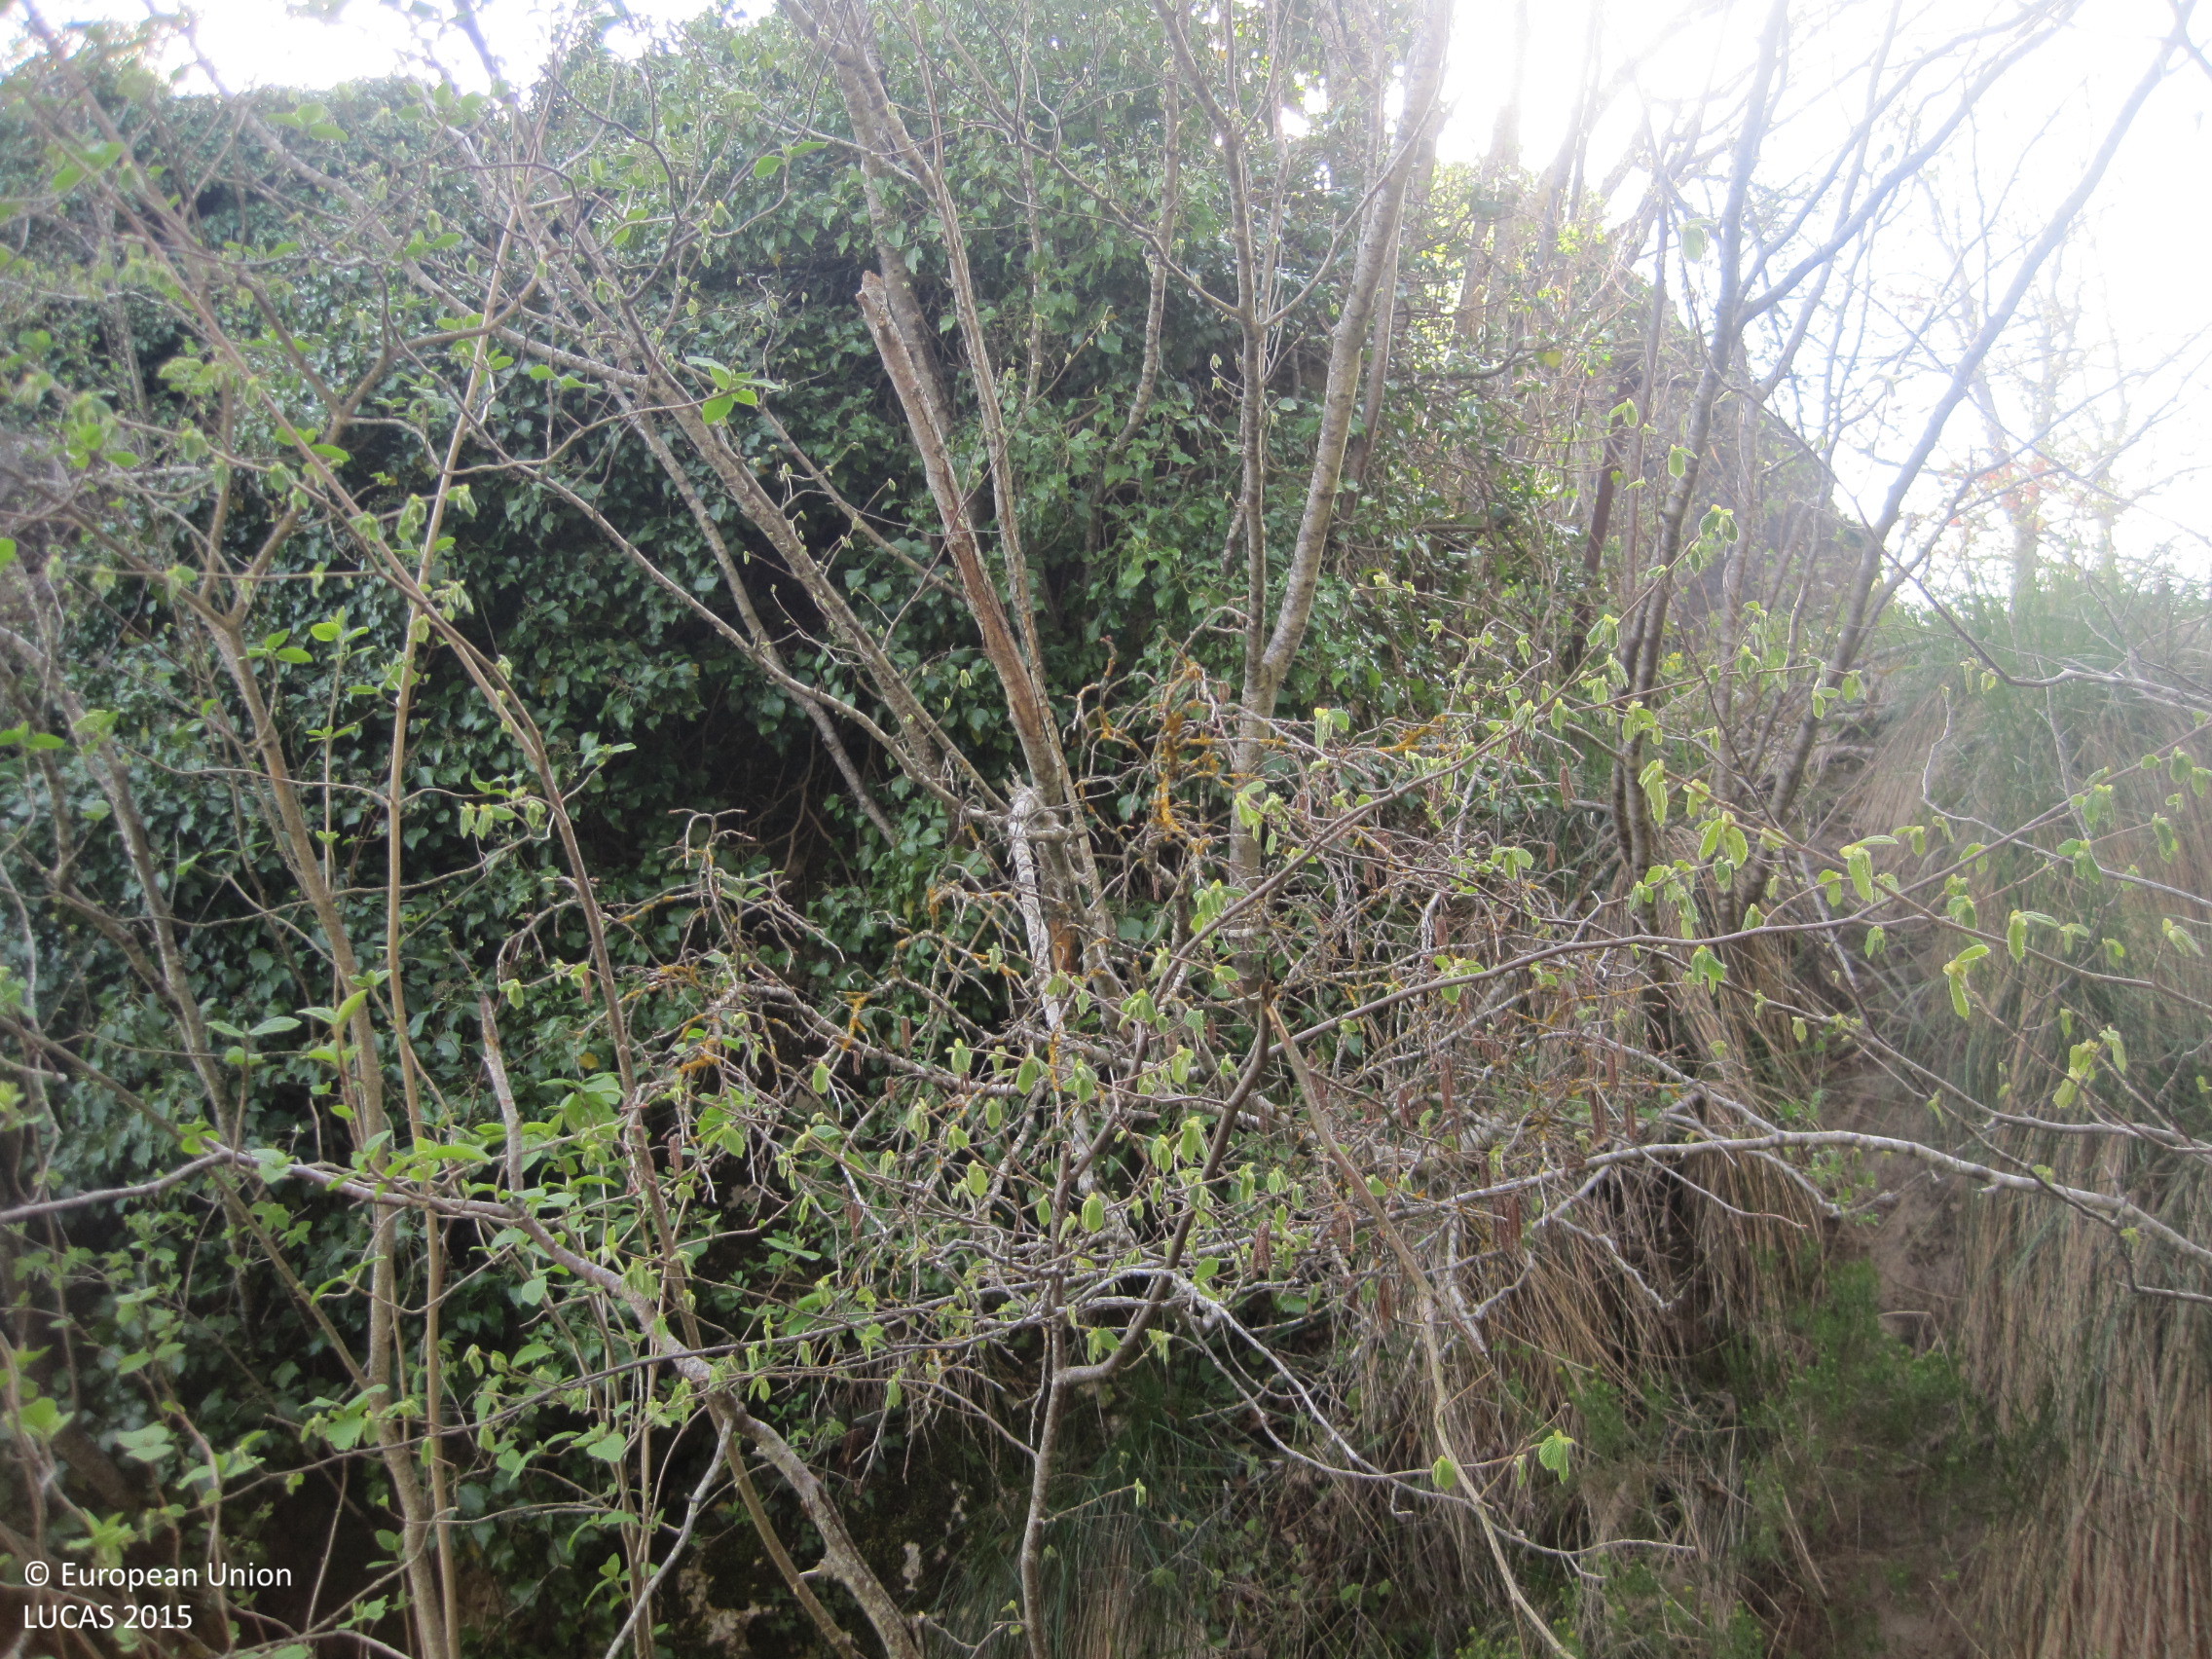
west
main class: Woodland
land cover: Broadleaved woodland
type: thermophilous deciduous forest
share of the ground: > 75 %
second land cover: Grassland without tree/shrub cover
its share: 25 - 50 %
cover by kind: broadleaved forest trees 40 %, shrubs 25 %, herbaceous plants 25 %, consolidated bare surface 10 %
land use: Forestry
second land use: Agriculture (excluding fallow land and kitchen gardens)
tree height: > 5 m
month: April
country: ES
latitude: 42.7822
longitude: -2.2570
